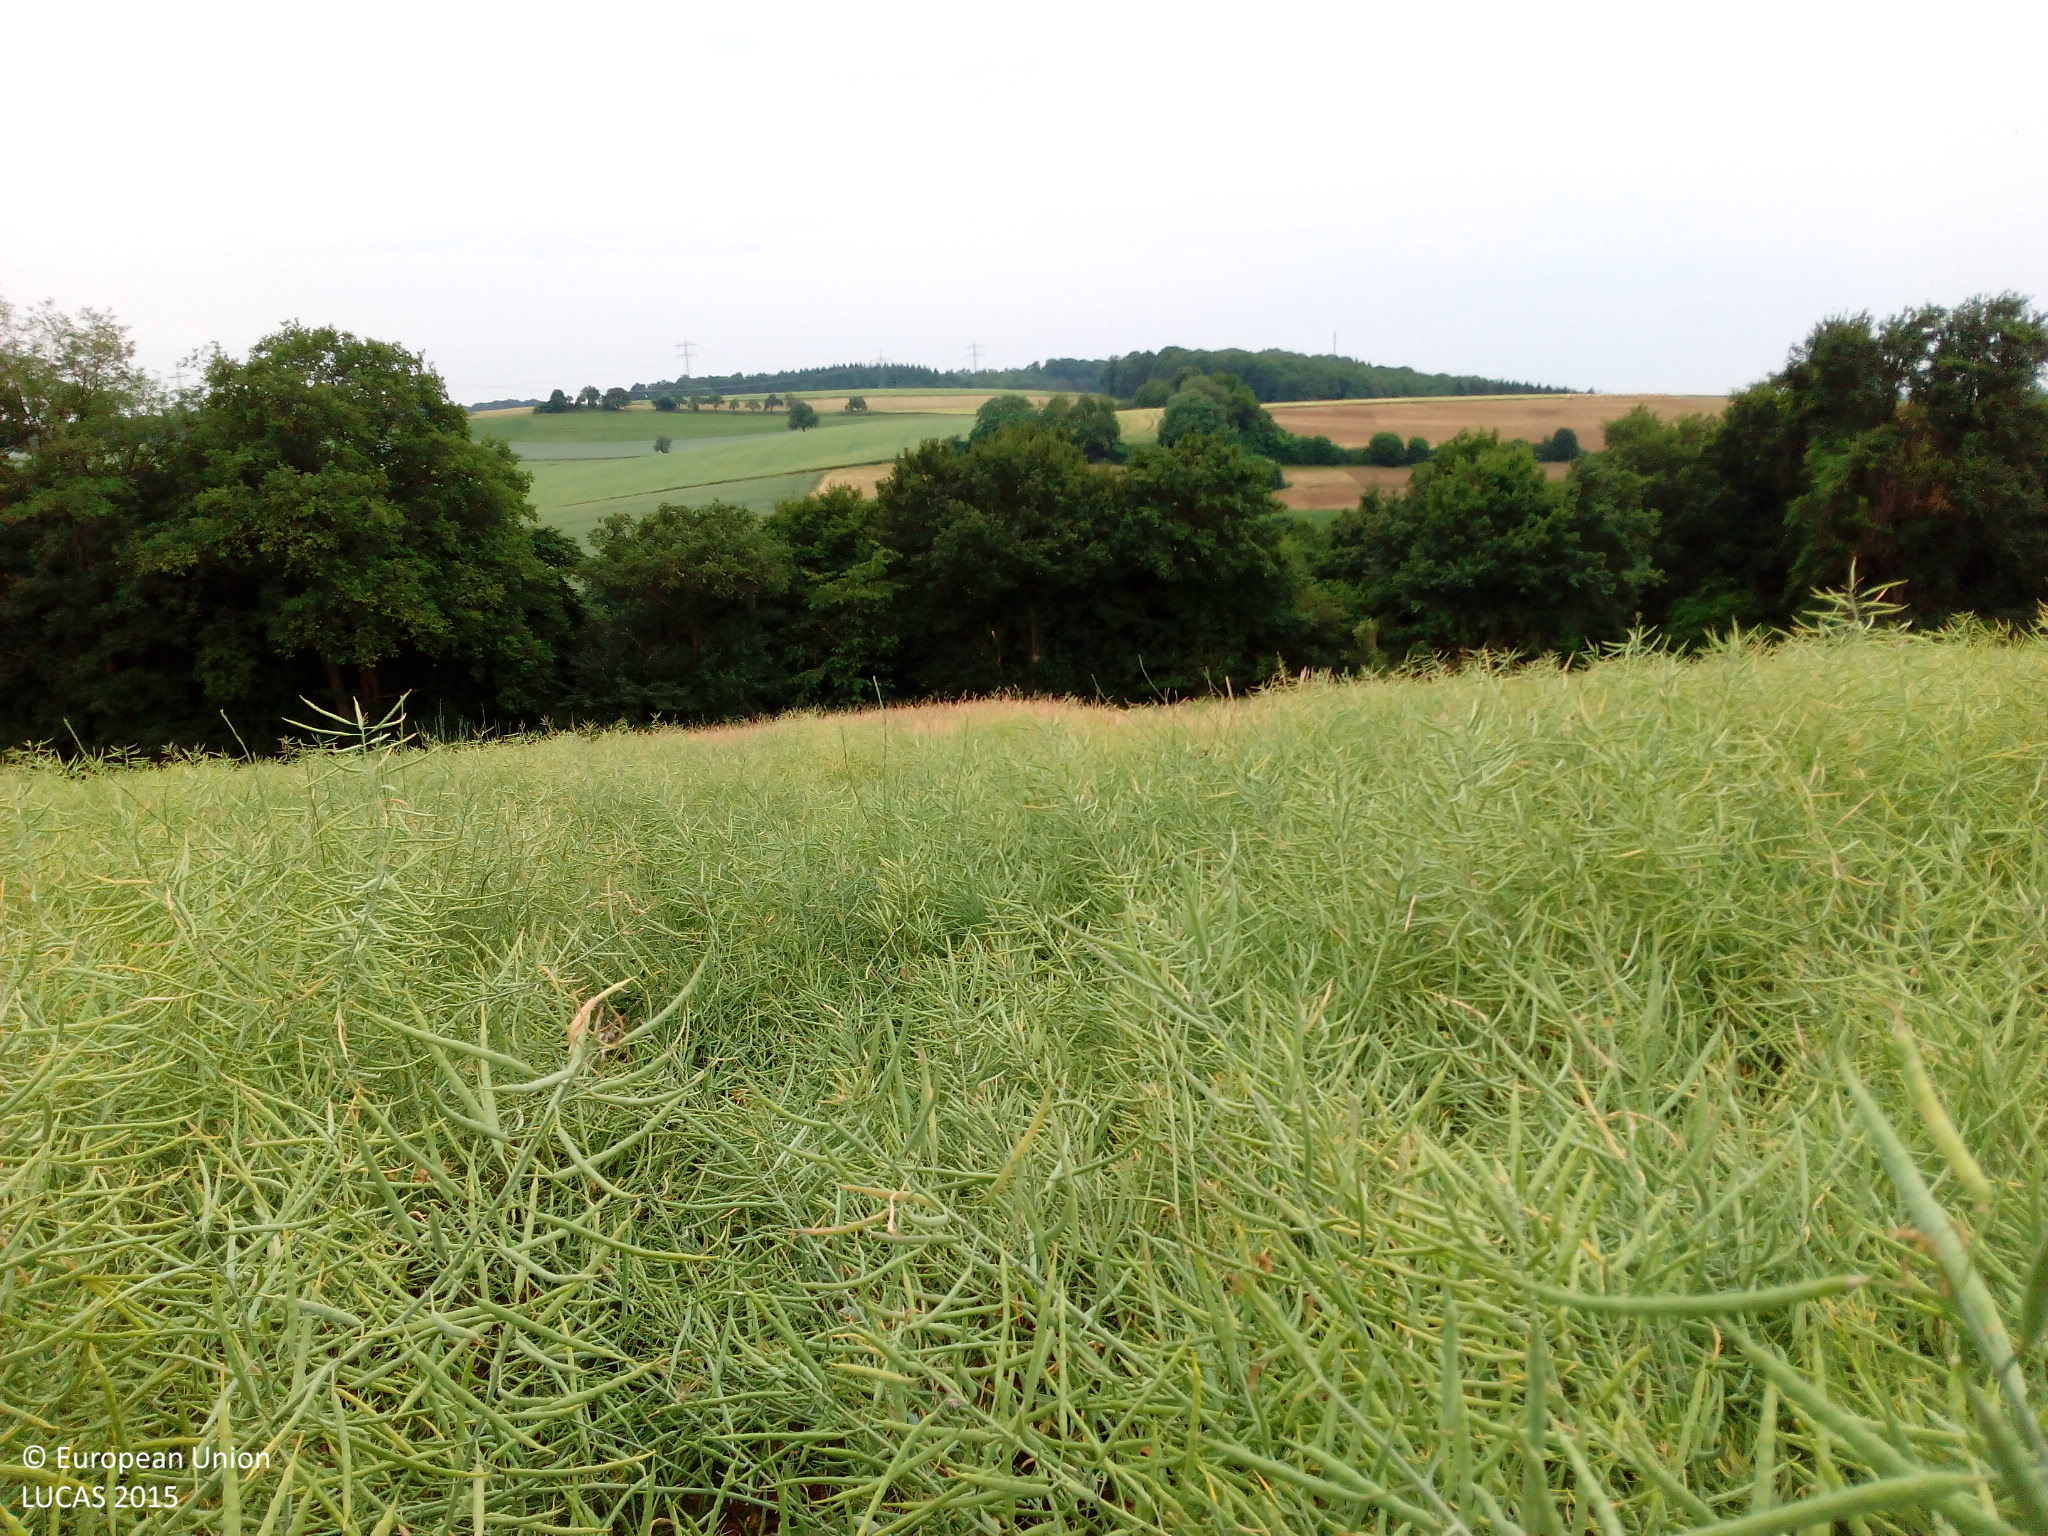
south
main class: Cropland
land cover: Rape and turnip rape
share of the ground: > 75 %
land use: Agriculture (excluding fallow land and kitchen gardens)
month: June
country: DE
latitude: 49.3546
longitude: 9.2706
